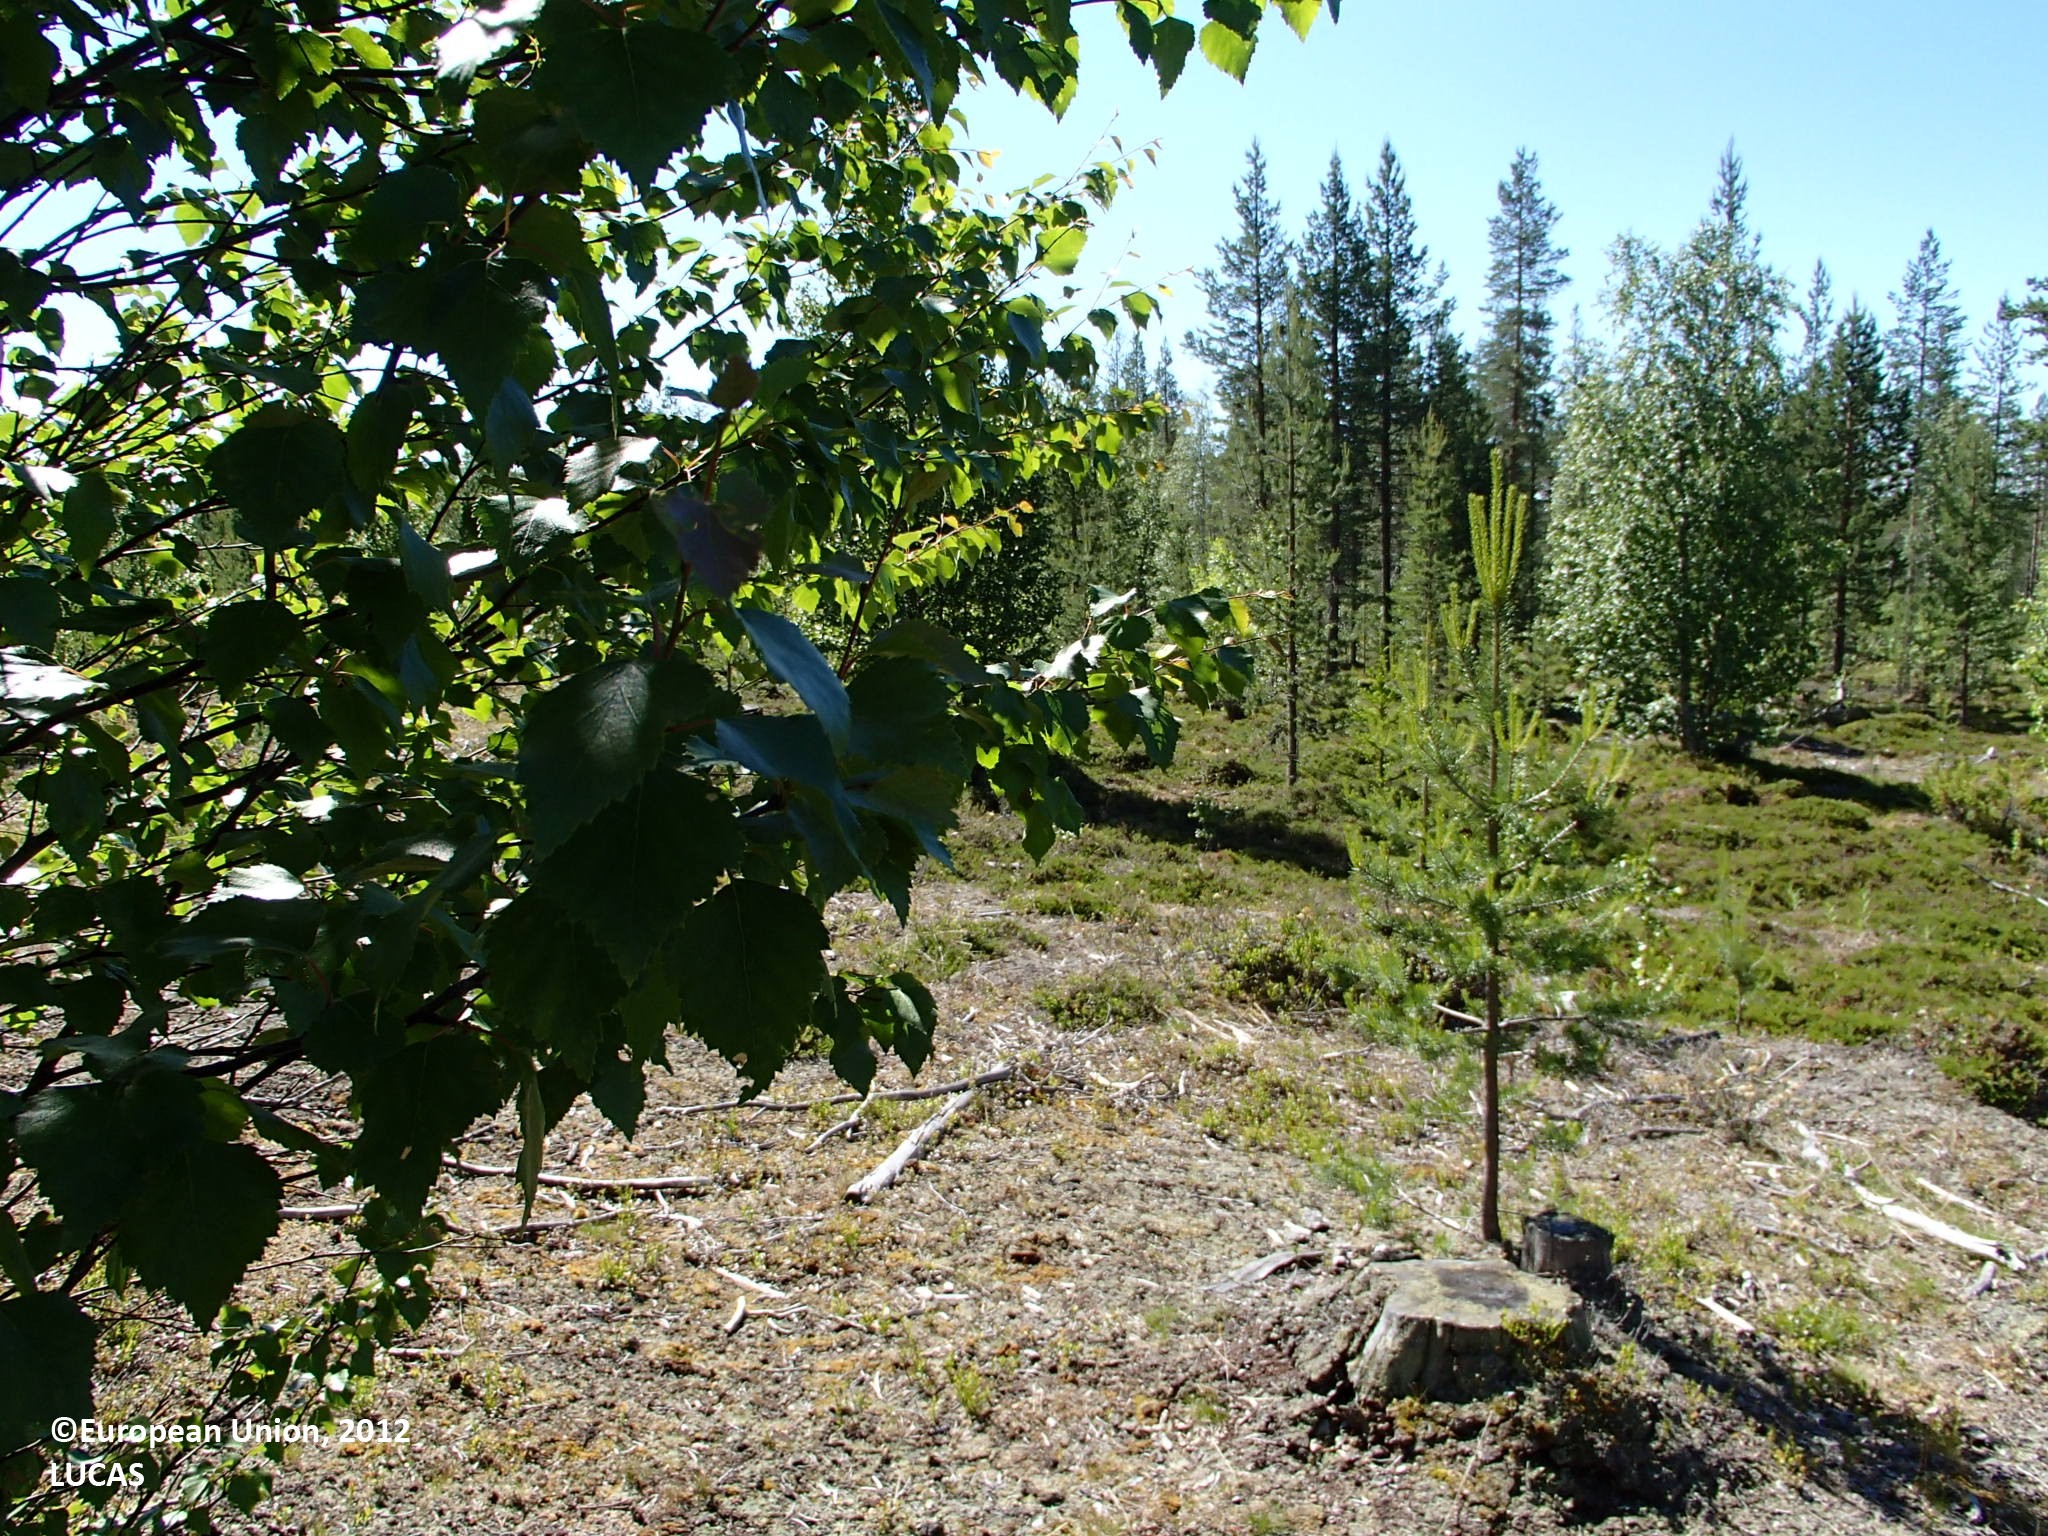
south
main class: Woodland
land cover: Other mixed woodland
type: boreal forest
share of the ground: 10 - 25 %
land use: Forestry
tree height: > 5 m
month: July
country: FI
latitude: 67.1153
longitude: 26.6497
